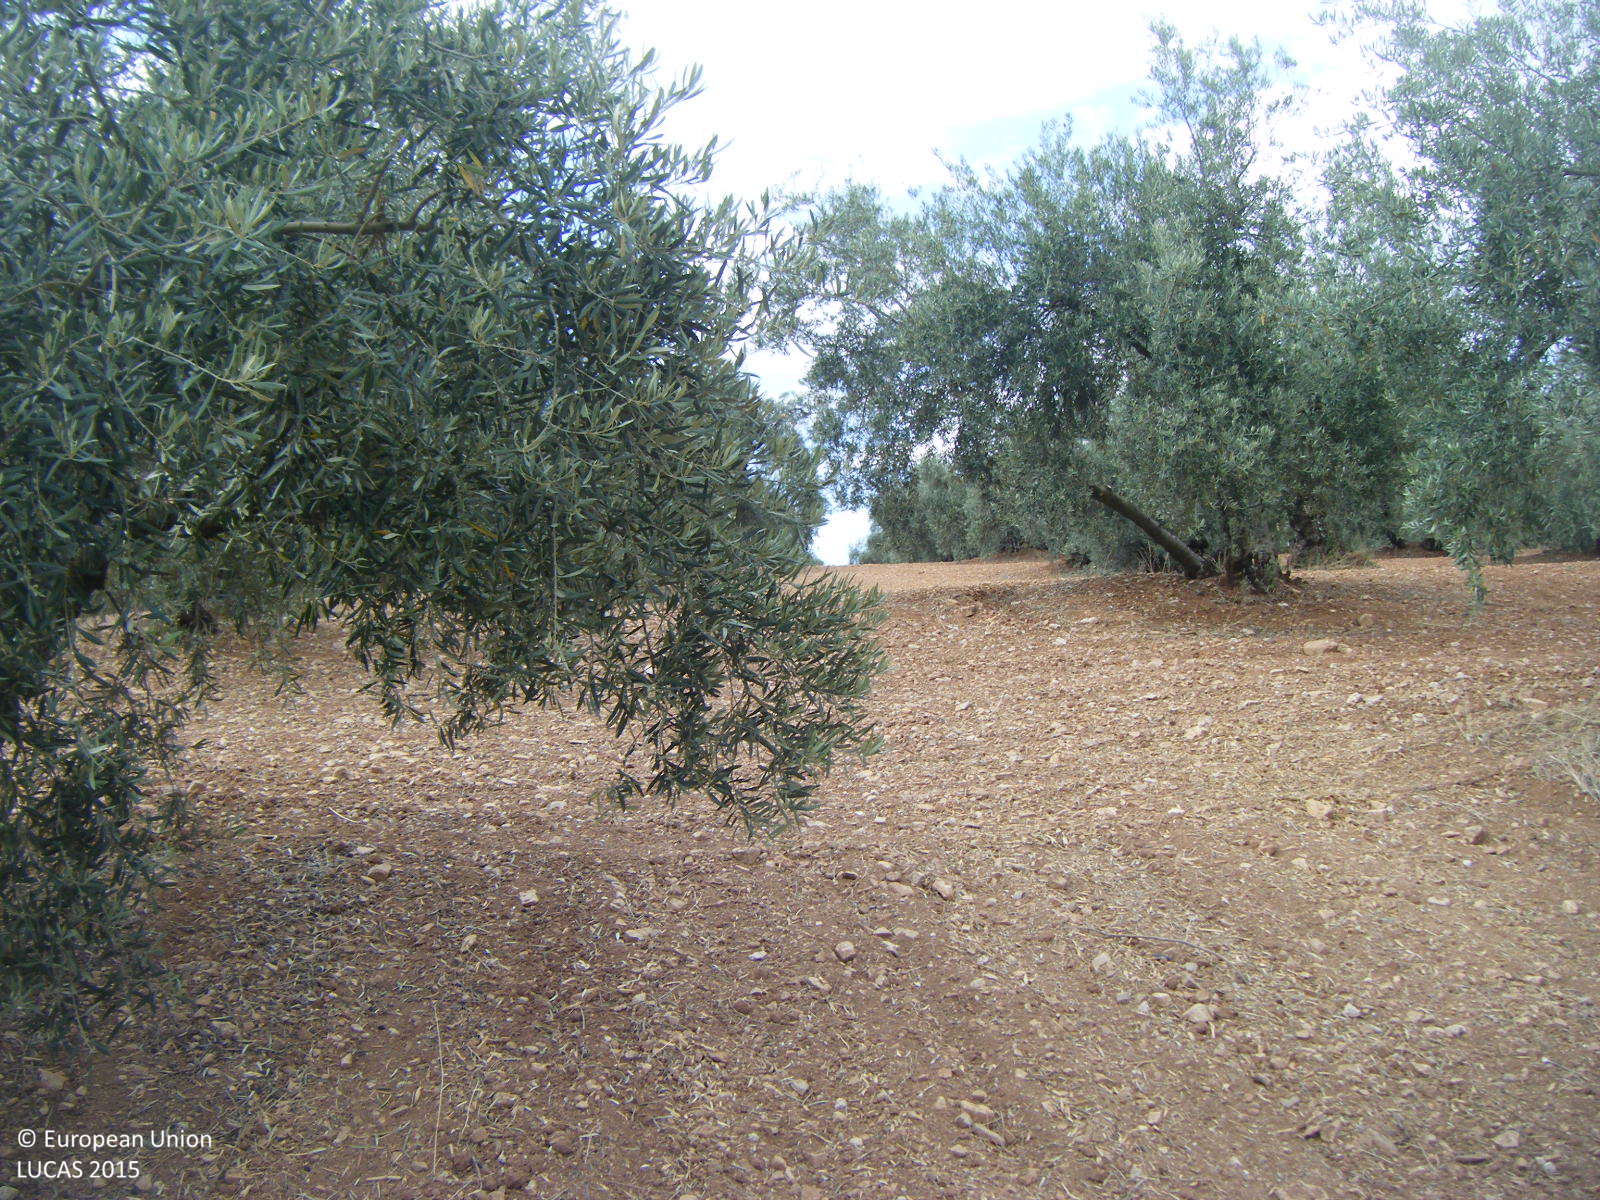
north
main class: Cropland
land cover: Olive groves
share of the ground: 25 - 50 %
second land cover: Other bare soil
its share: > 75 %
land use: Agriculture (excluding fallow land and kitchen gardens)
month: May
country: ES
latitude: 37.1924
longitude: -4.4293
